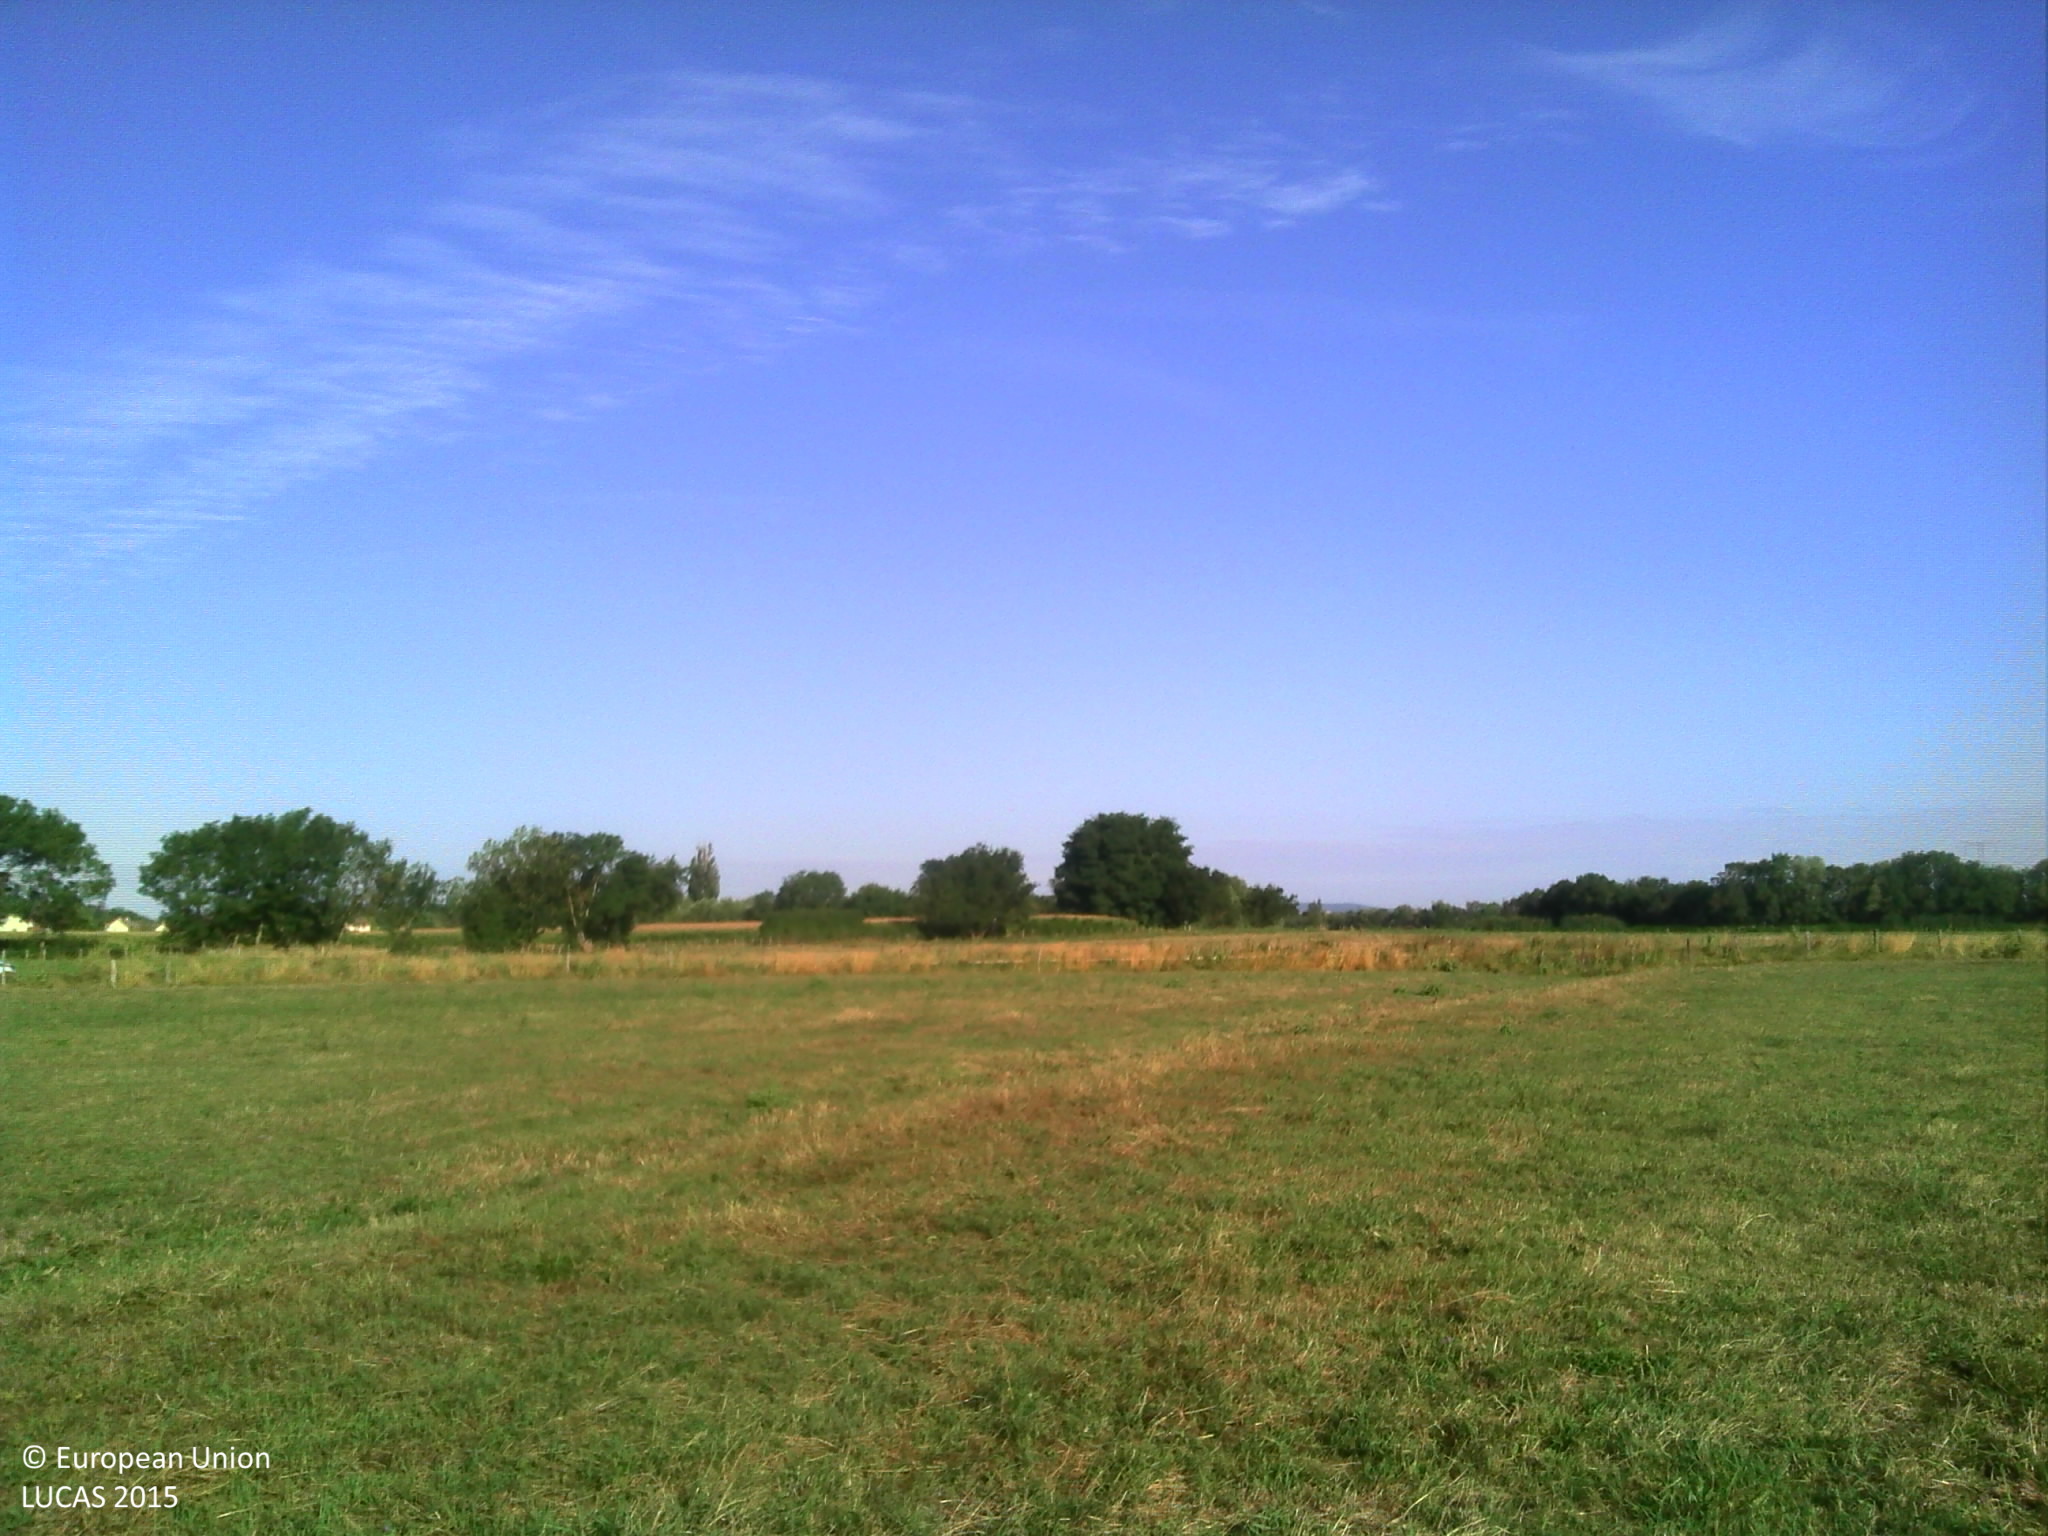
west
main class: Grassland
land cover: Grassland without tree/shrub cover
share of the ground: > 75 %
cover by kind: herbaceous plants 100 %
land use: Agriculture (excluding fallow land and kitchen gardens)
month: July
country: FR
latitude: 46.7161
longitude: 4.8864
